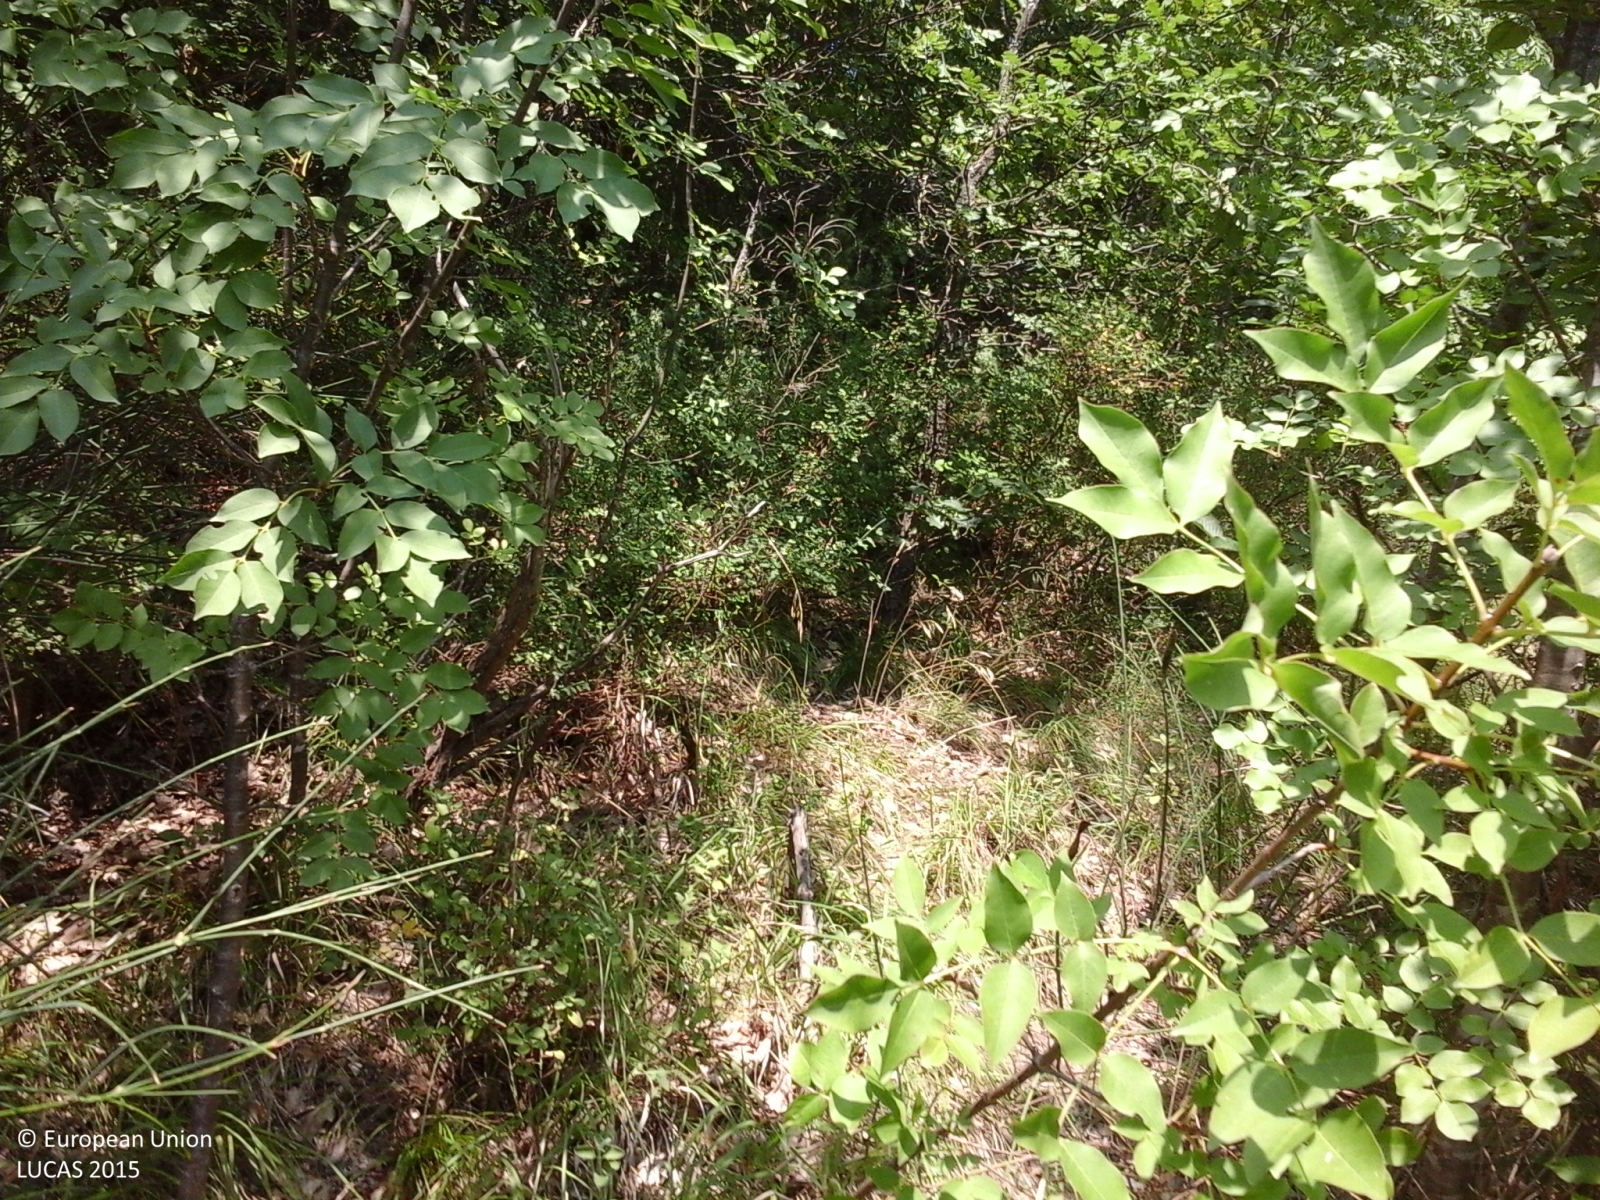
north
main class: Woodland
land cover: Broadleaved woodland
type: mesophytic deciduous forest
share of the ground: > 75 %
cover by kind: broadleaved forest trees 100 %
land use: Forestry
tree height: > 5 m
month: August
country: IT
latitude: 43.0757
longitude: 13.1232
